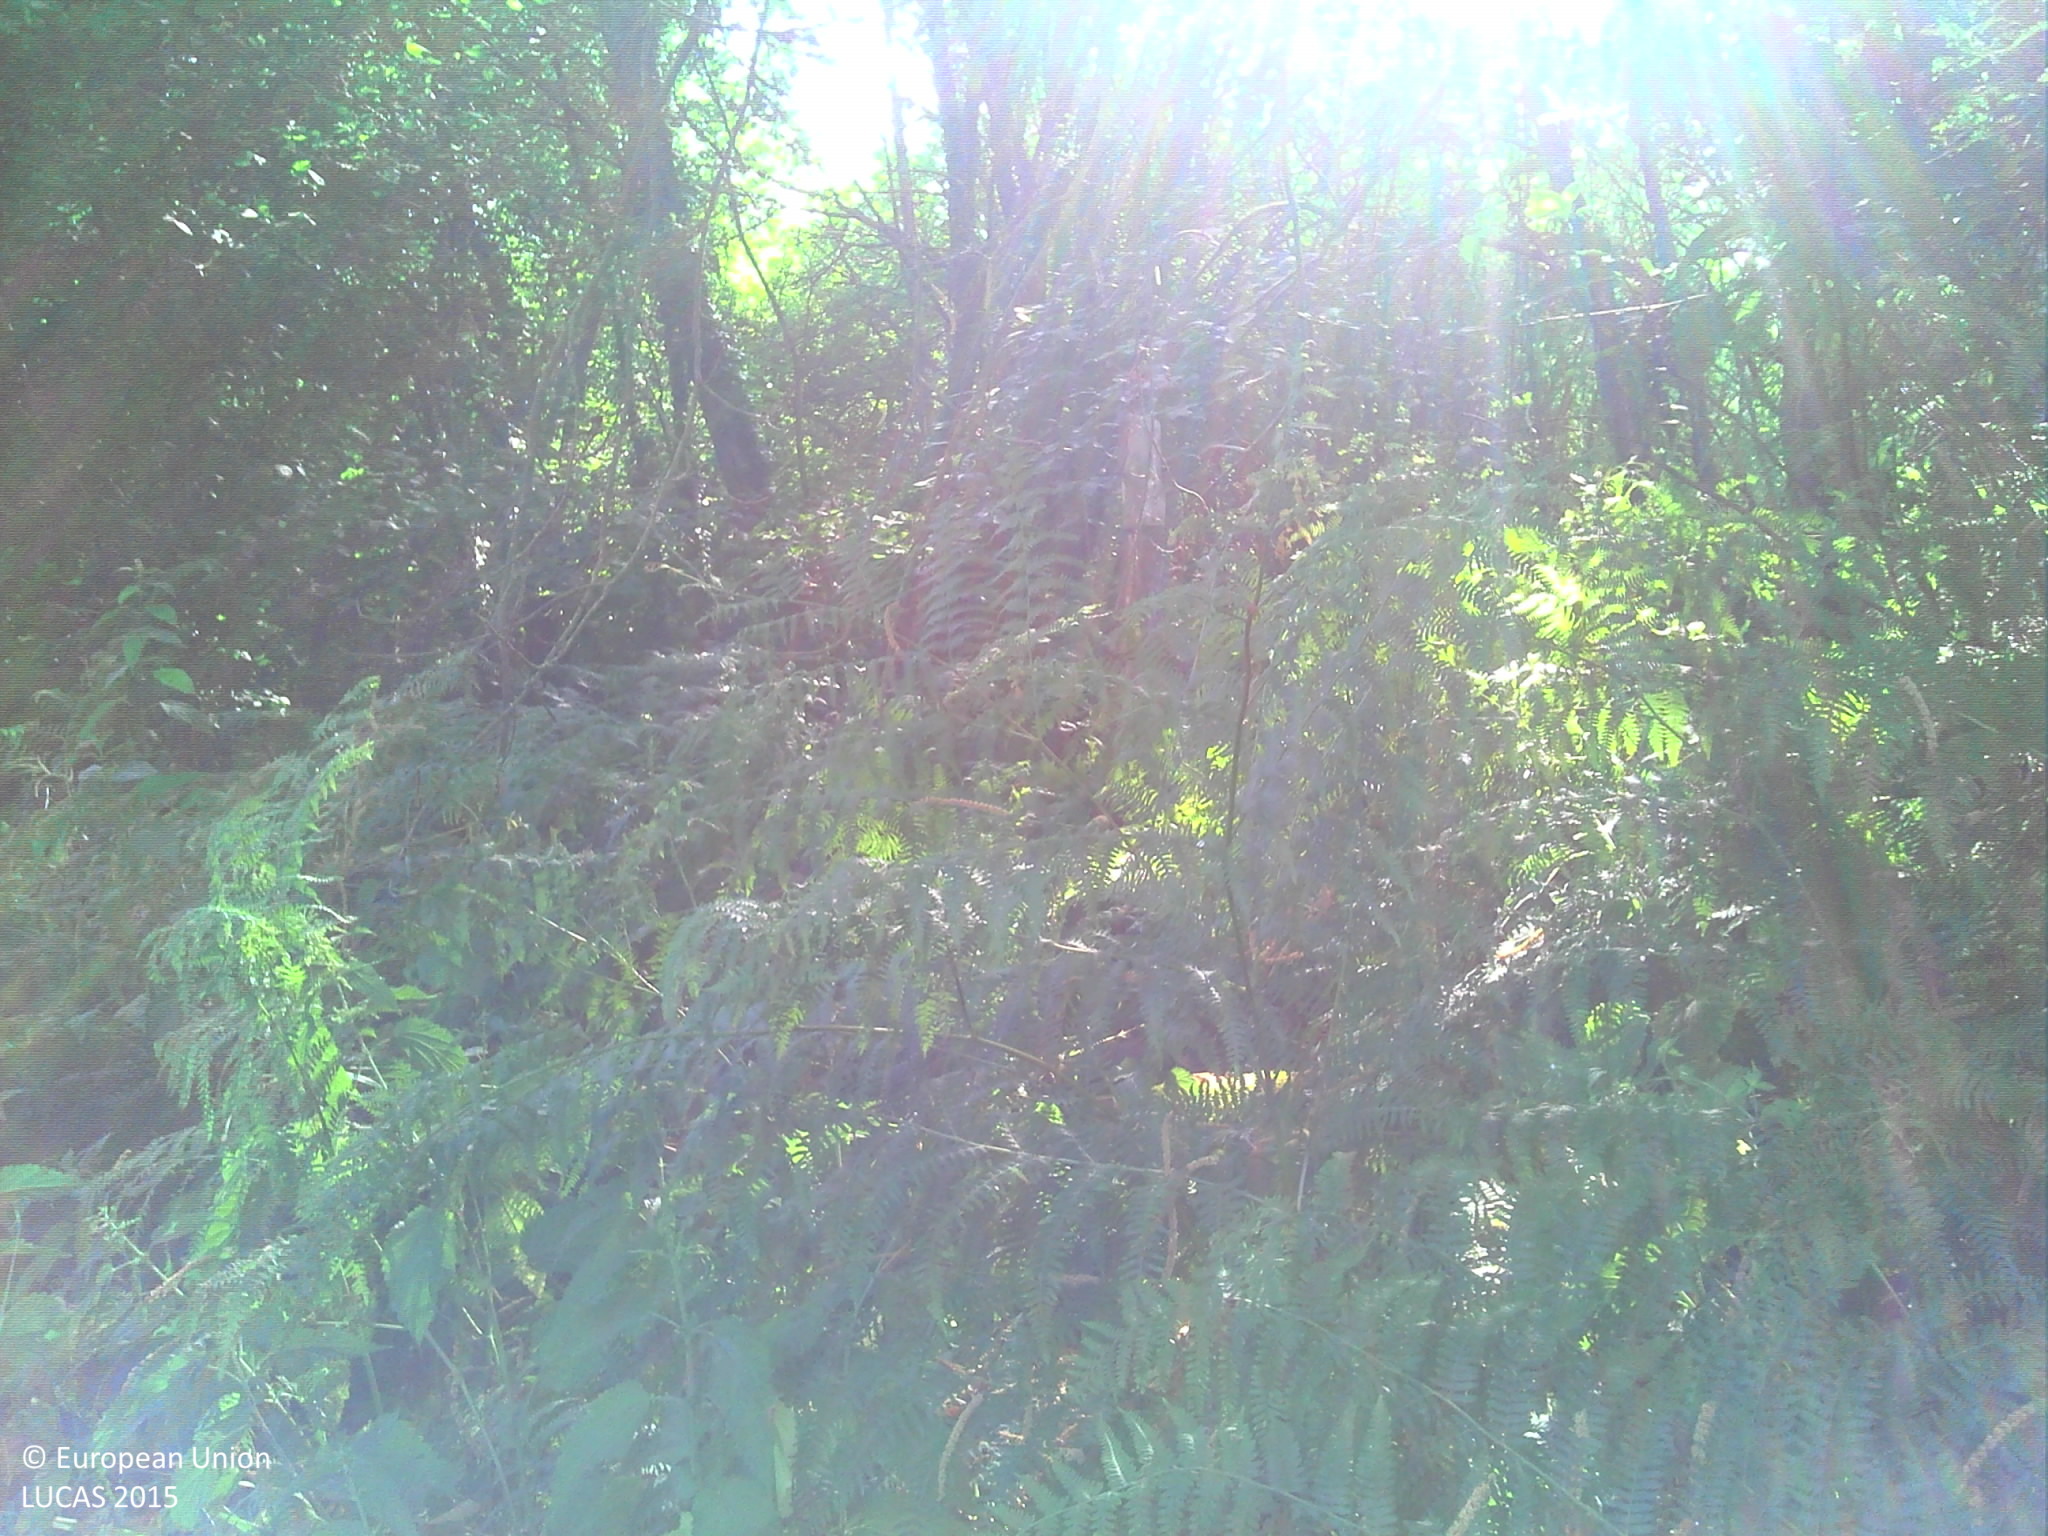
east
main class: Woodland
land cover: Broadleaved woodland
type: mesophytic deciduous forest
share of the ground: 50 - 75 %
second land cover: Spontaneously vegetated surfaces
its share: > 75 %
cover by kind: broadleaved forest trees 60 %, shrubs 30 %, herbaceous plants 10 %
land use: Forestry
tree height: > 5 m
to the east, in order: Broadleaved woodland; Spontaneously vegetated surfaces; Tracks; Broadleaved woodland; Tracks; Broadleaved woodland; Pine dominated coniferous woodland
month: July
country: FR
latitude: 47.7078
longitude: 0.3404
